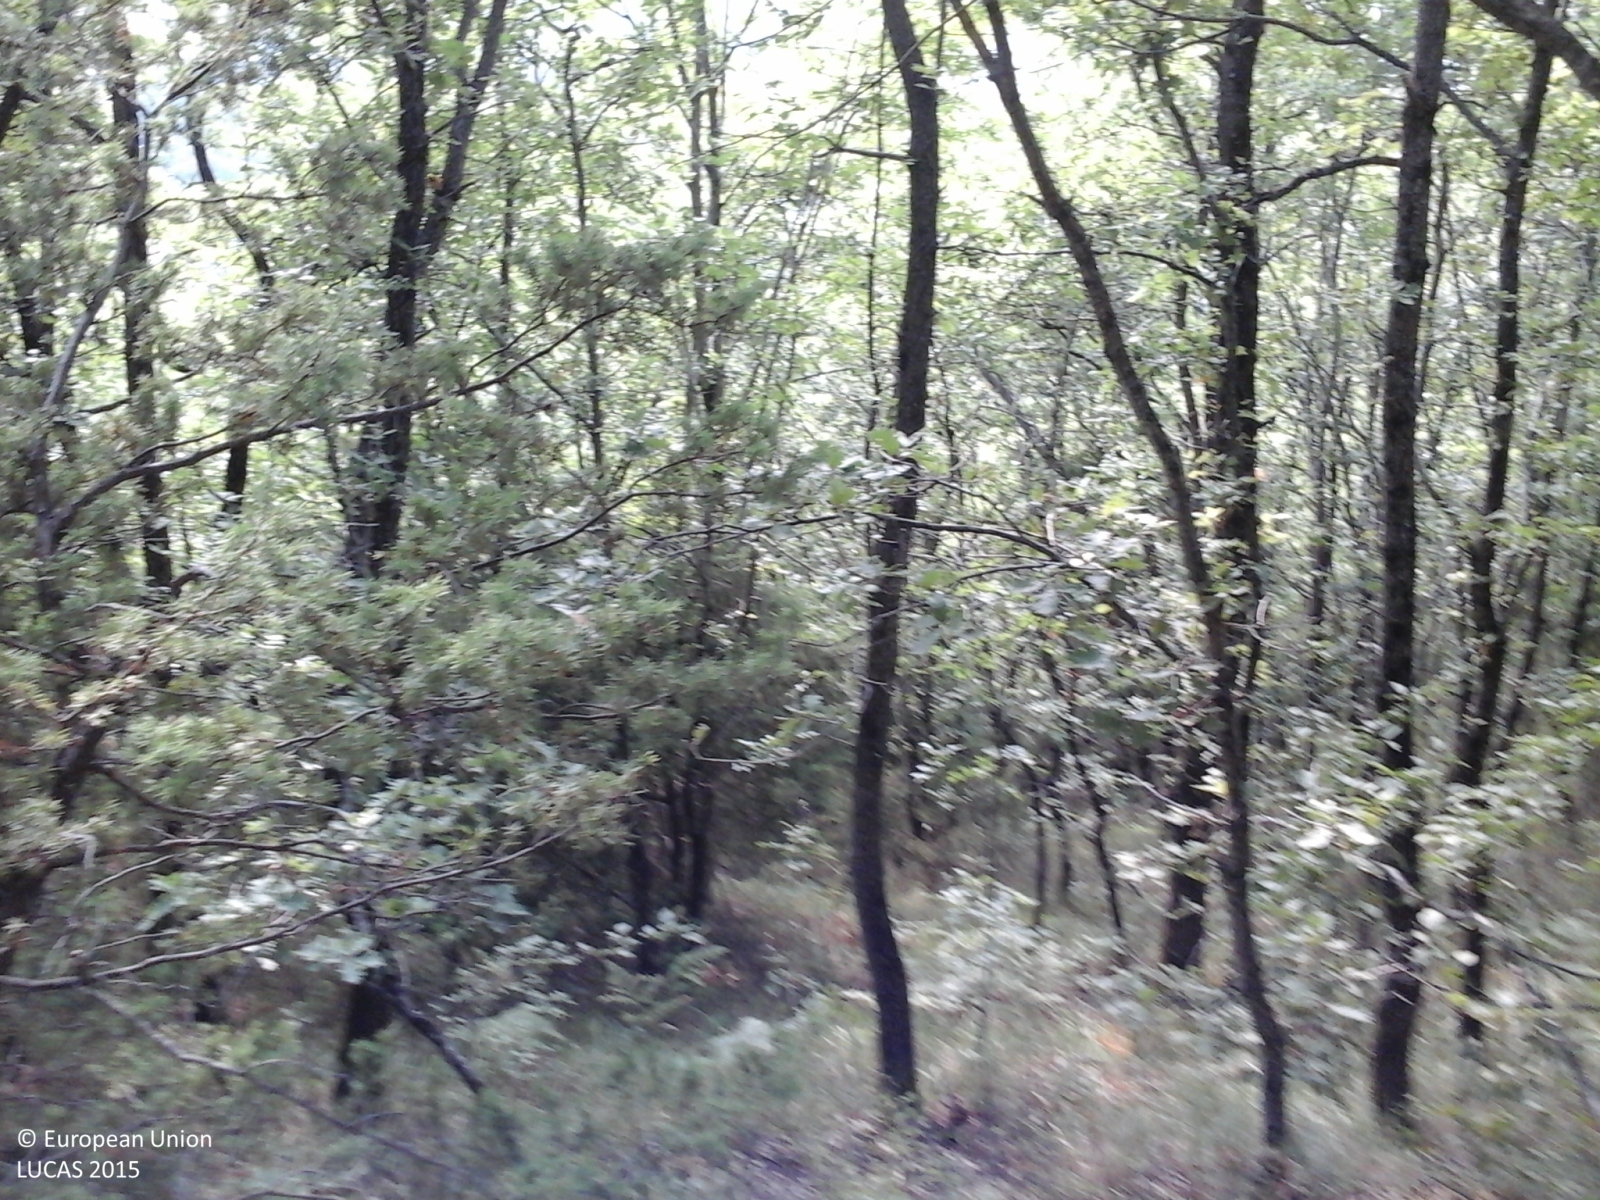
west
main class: Woodland
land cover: Broadleaved woodland
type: thermophilous deciduous forest
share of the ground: > 75 %
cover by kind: broadleaved forest trees 100 %
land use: Forestry
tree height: > 5 m
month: August
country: IT
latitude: 43.5778
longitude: 12.6062
